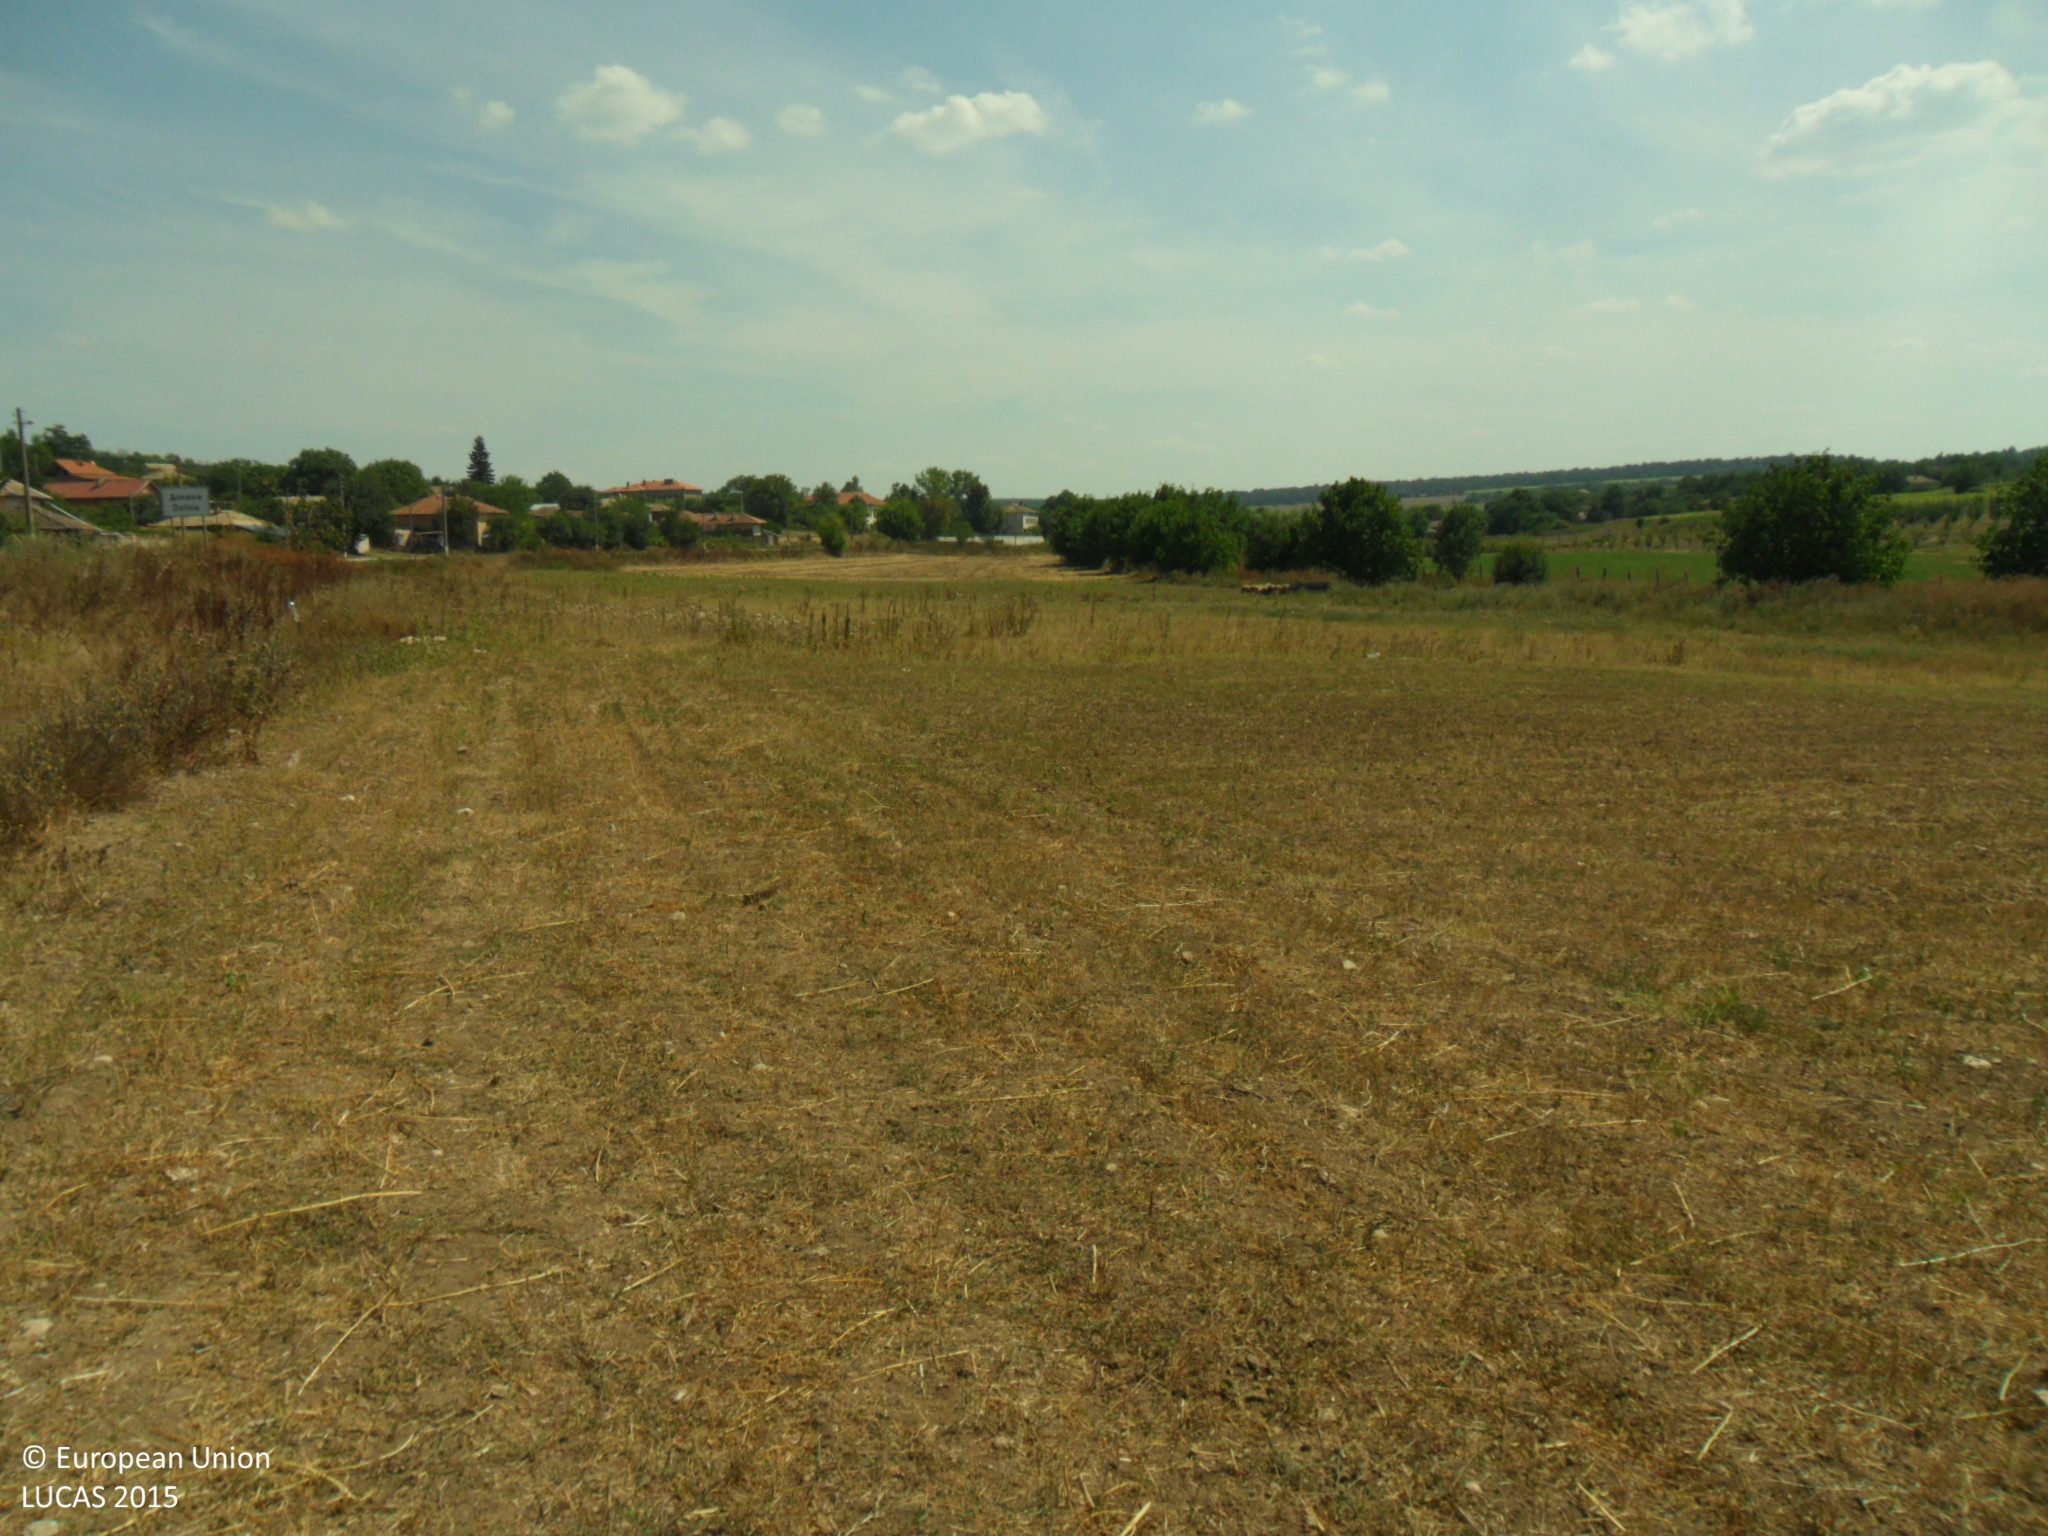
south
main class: Grassland
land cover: Grassland with sparse tree/shrub cover
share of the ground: > 75 %
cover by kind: herbaceous plants 90 %, broadleaved forest trees 5 %, shrubs 5 %
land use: Agriculture (excluding fallow land and kitchen gardens)
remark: Harvested field
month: August
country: BG
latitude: 43.5418
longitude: 27.1132
